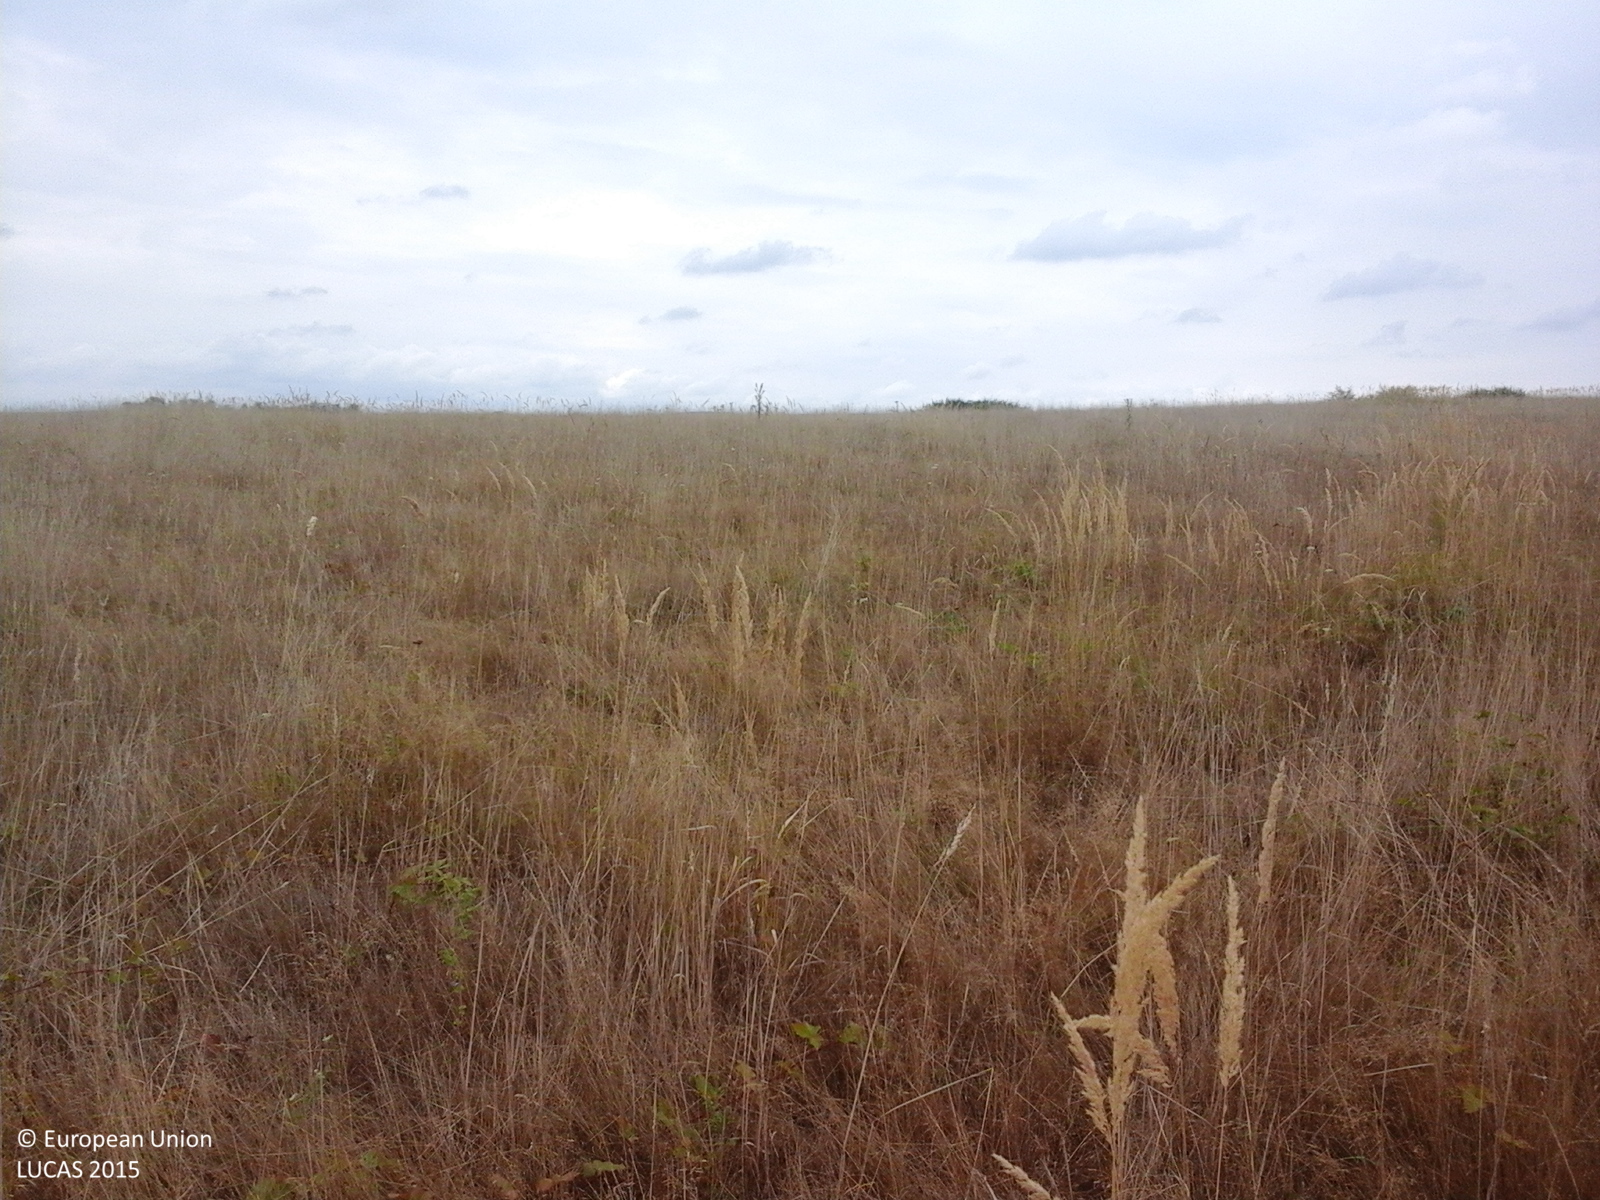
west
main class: Grassland
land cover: Grassland without tree/shrub cover
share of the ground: > 75 %
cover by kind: herbaceous plants 100 %
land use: Agriculture (excluding fallow land and kitchen gardens)
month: August
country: RO
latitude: 45.8922
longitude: 21.8307
